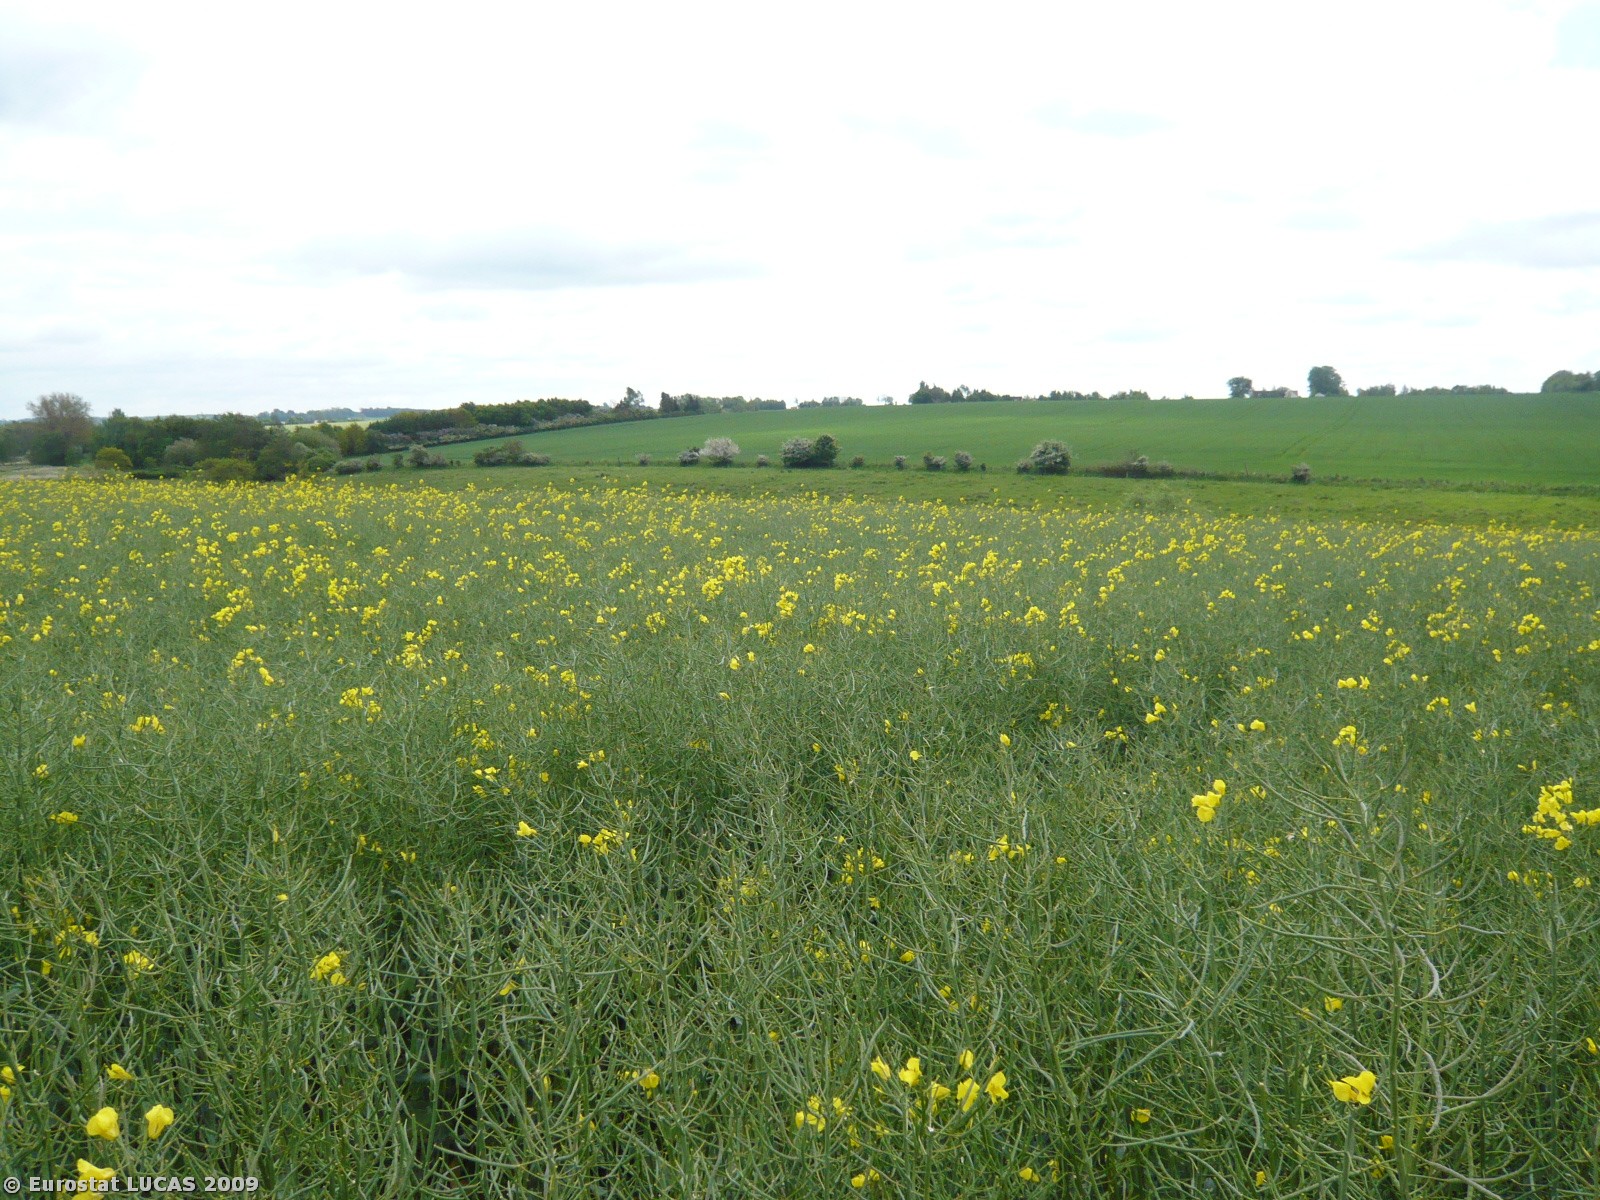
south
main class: Cropland
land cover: Rape and turnip rape
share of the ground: > 75 %
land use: Agriculture (excluding fallow land and kitchen gardens)
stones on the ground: < 10 %
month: May
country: DK
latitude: 55.4215
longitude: 11.6891
